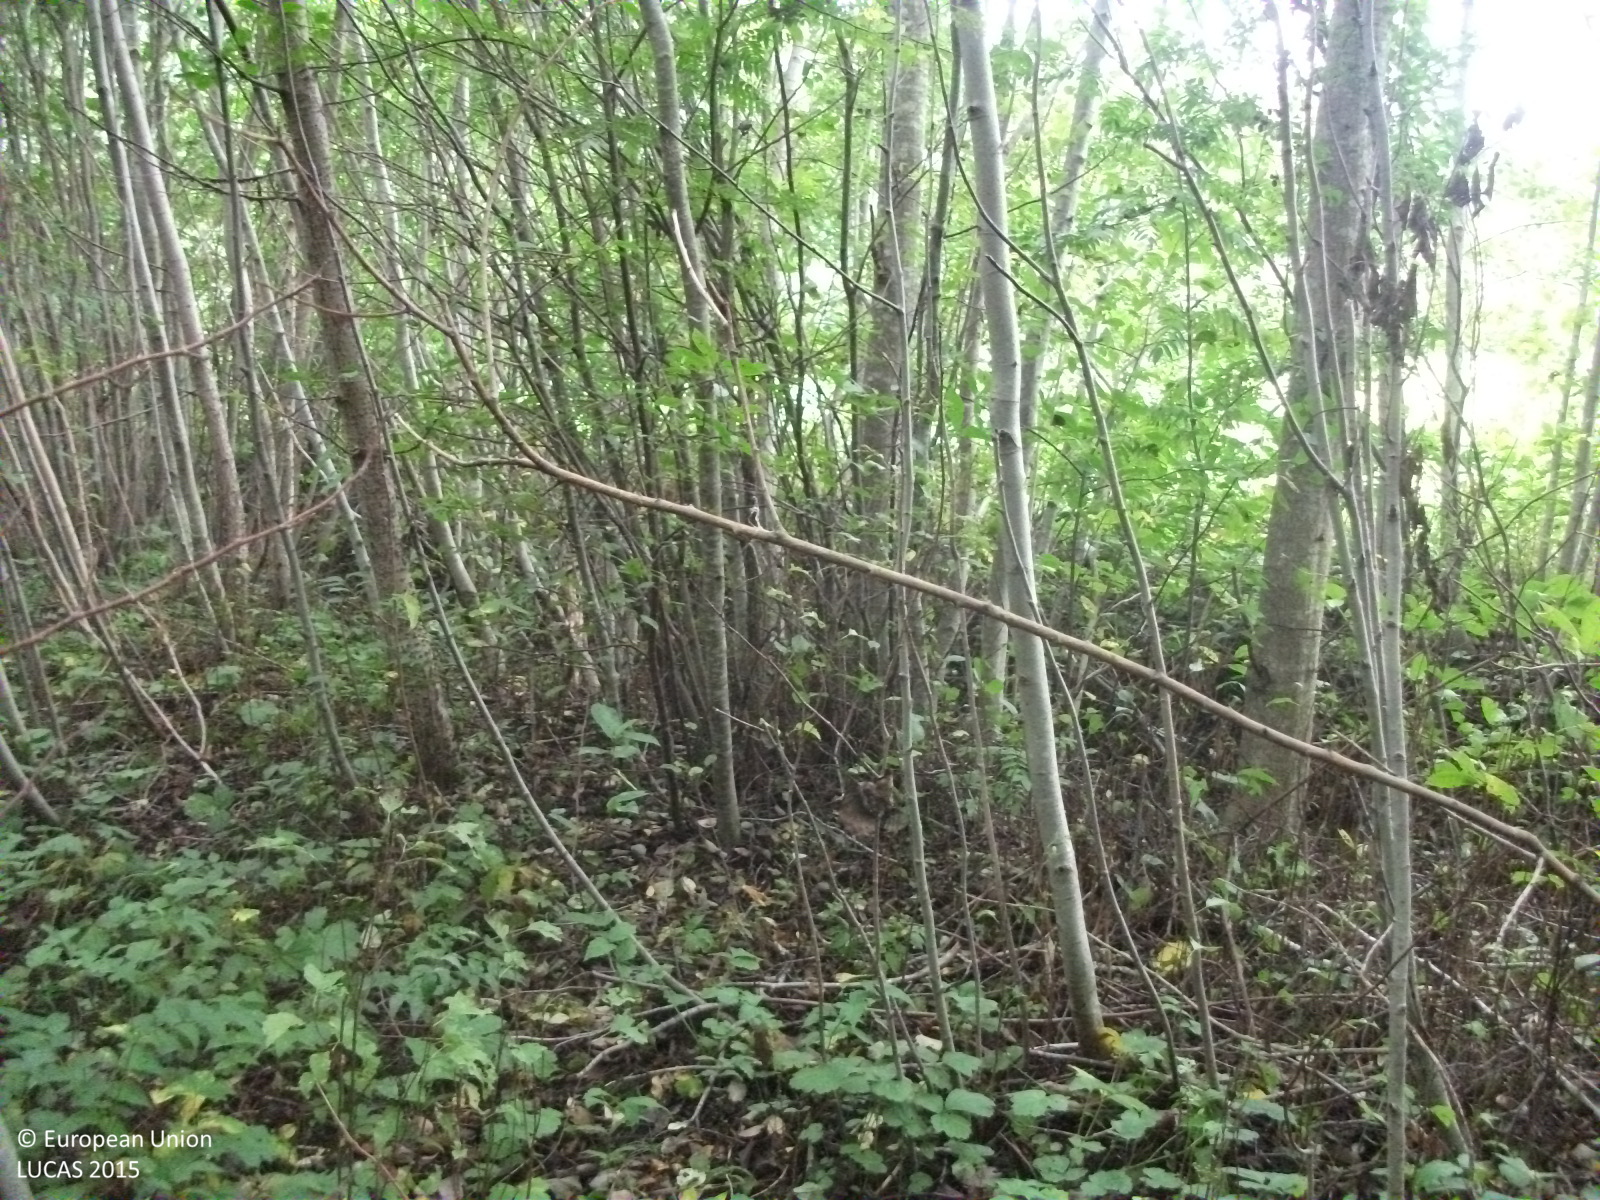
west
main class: Woodland
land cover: Broadleaved woodland
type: non-riverine alder, birch or aspen forest
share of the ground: > 75 %
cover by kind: broadleaved forest trees 80 %, herbaceous plants 10 %, shrubs 5 %, unconsolidated bare surface 5 %
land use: Forestry
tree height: > 5 m
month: September
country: LV
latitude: 57.4618
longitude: 24.6814
